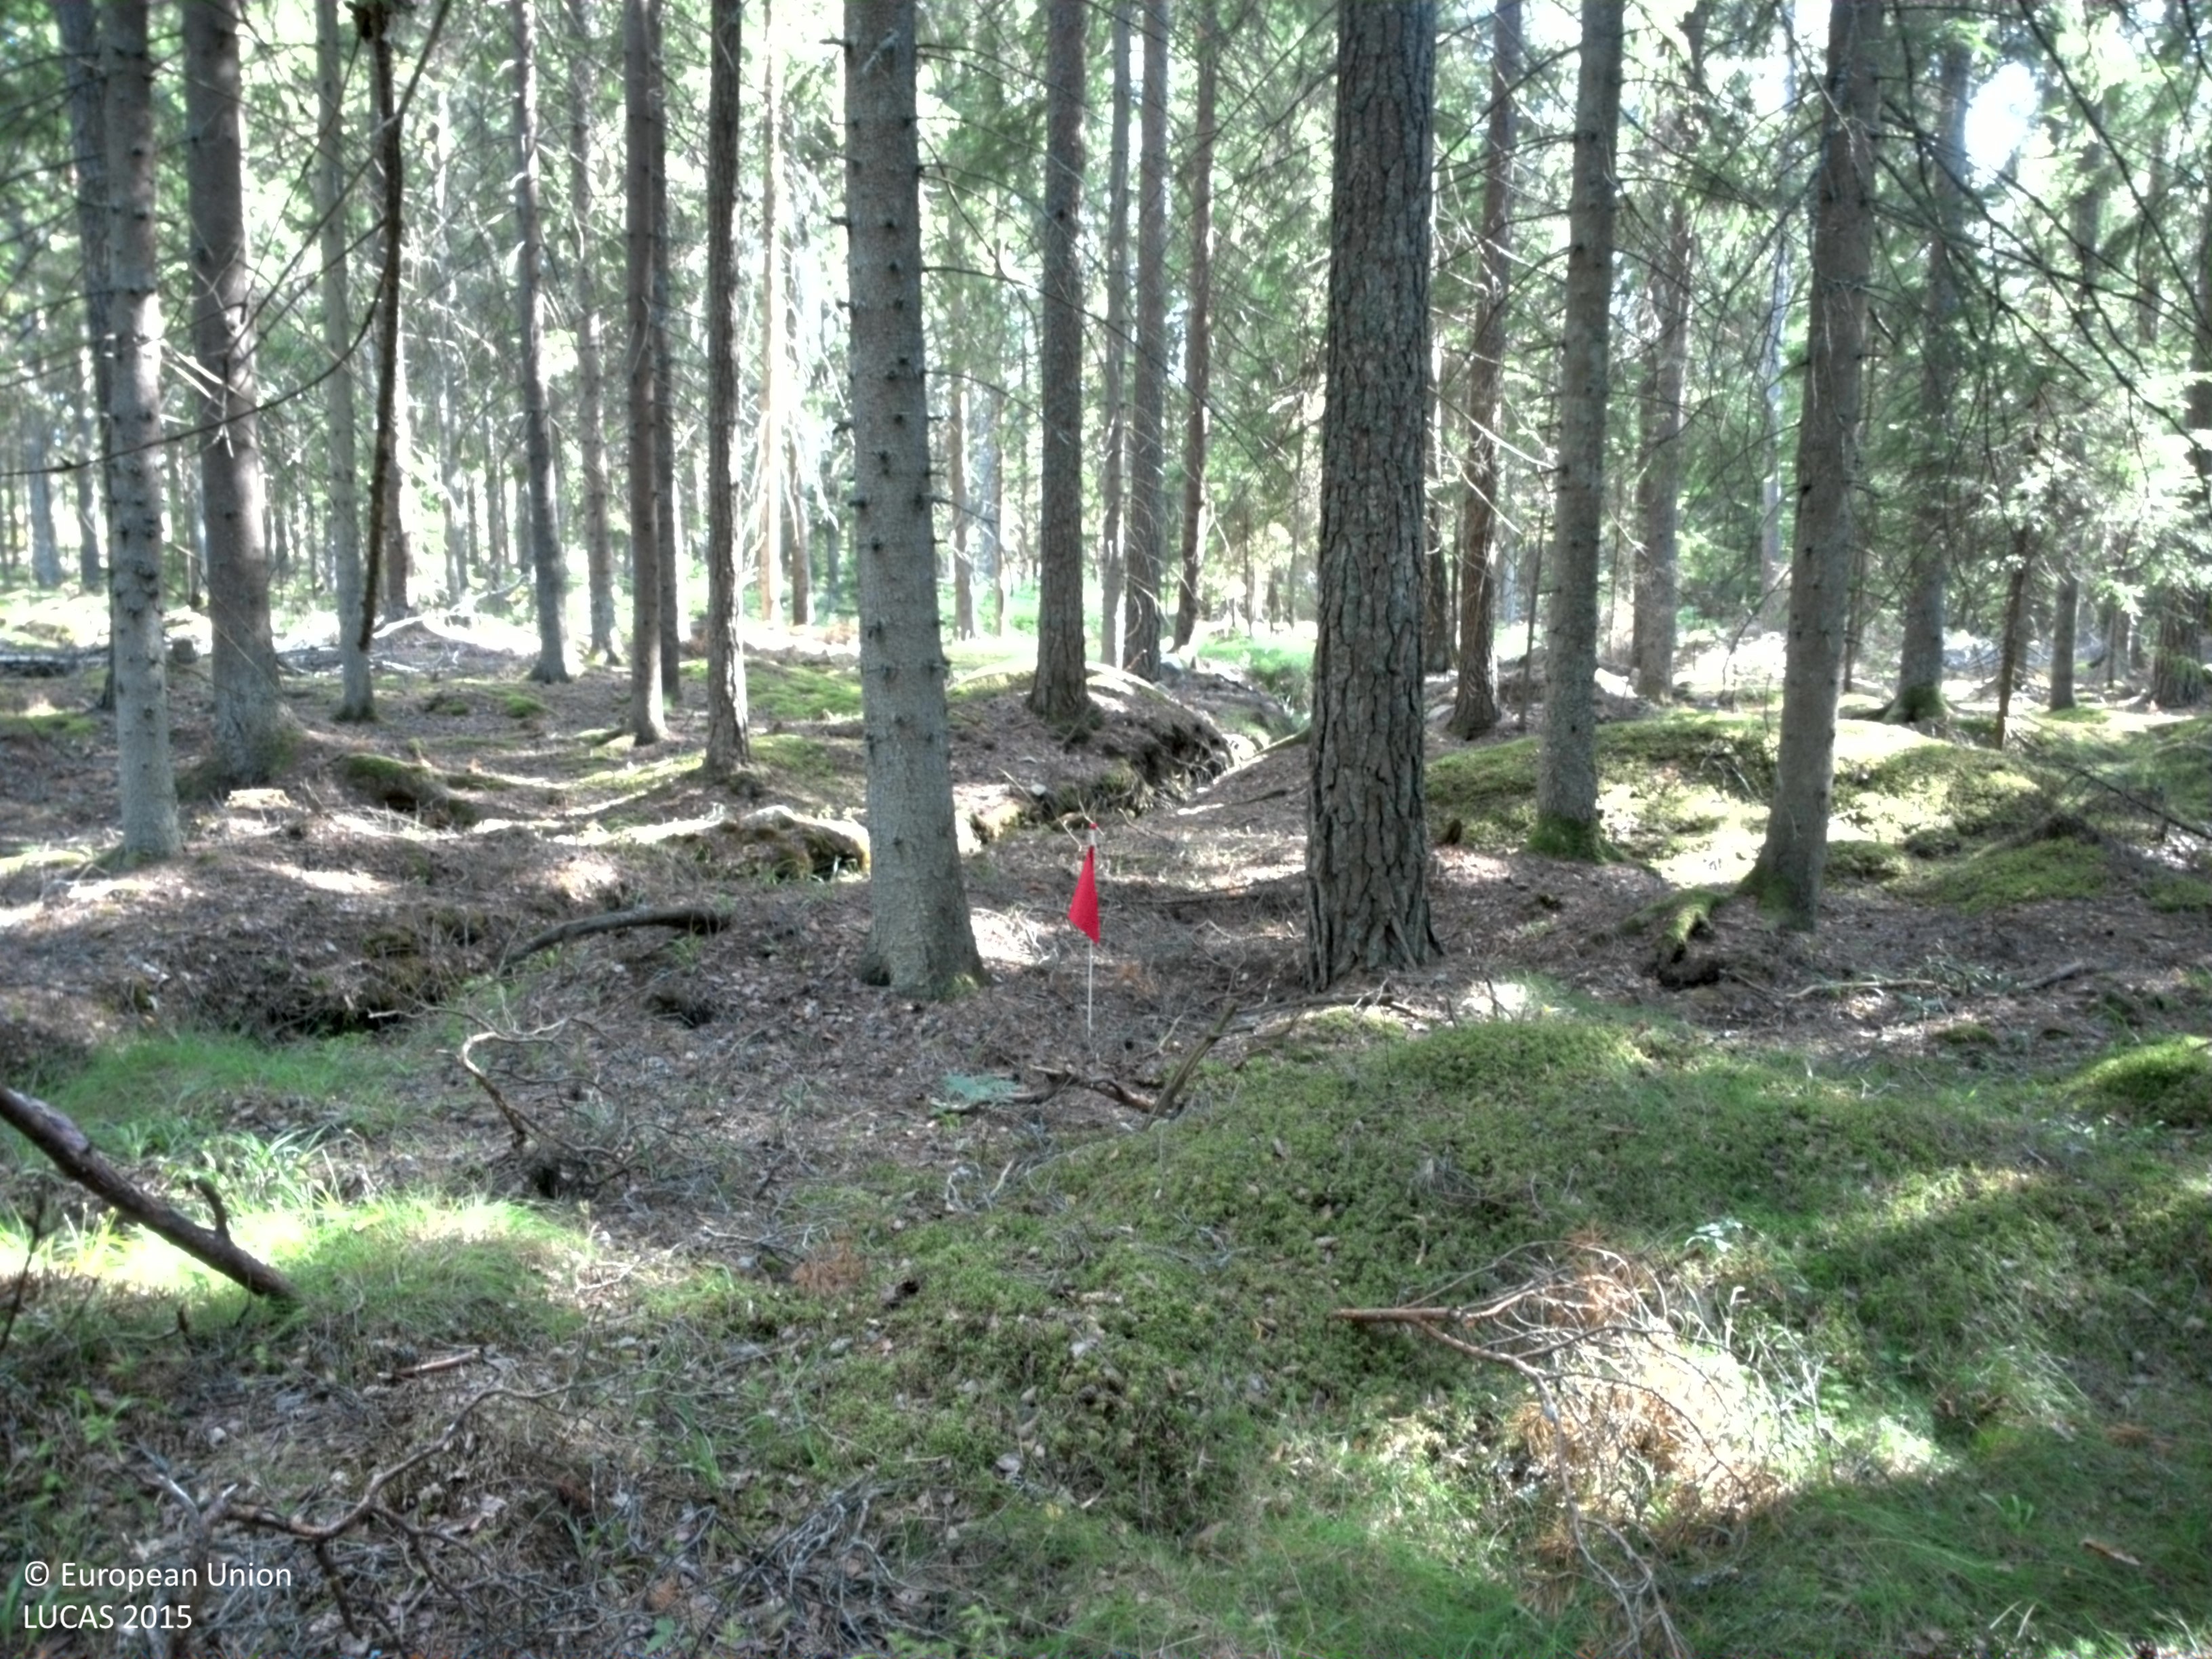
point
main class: Woodland
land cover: Spruce dominated coniferous woodland
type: boreal forest
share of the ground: 50 - 75 %
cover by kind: coniferous forest trees 75 %, lichens and mosses 20 %, unconsolidated bare surface 5 %
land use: Forestry
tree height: > 5 m
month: July
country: SE
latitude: 58.6461
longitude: 14.0080
